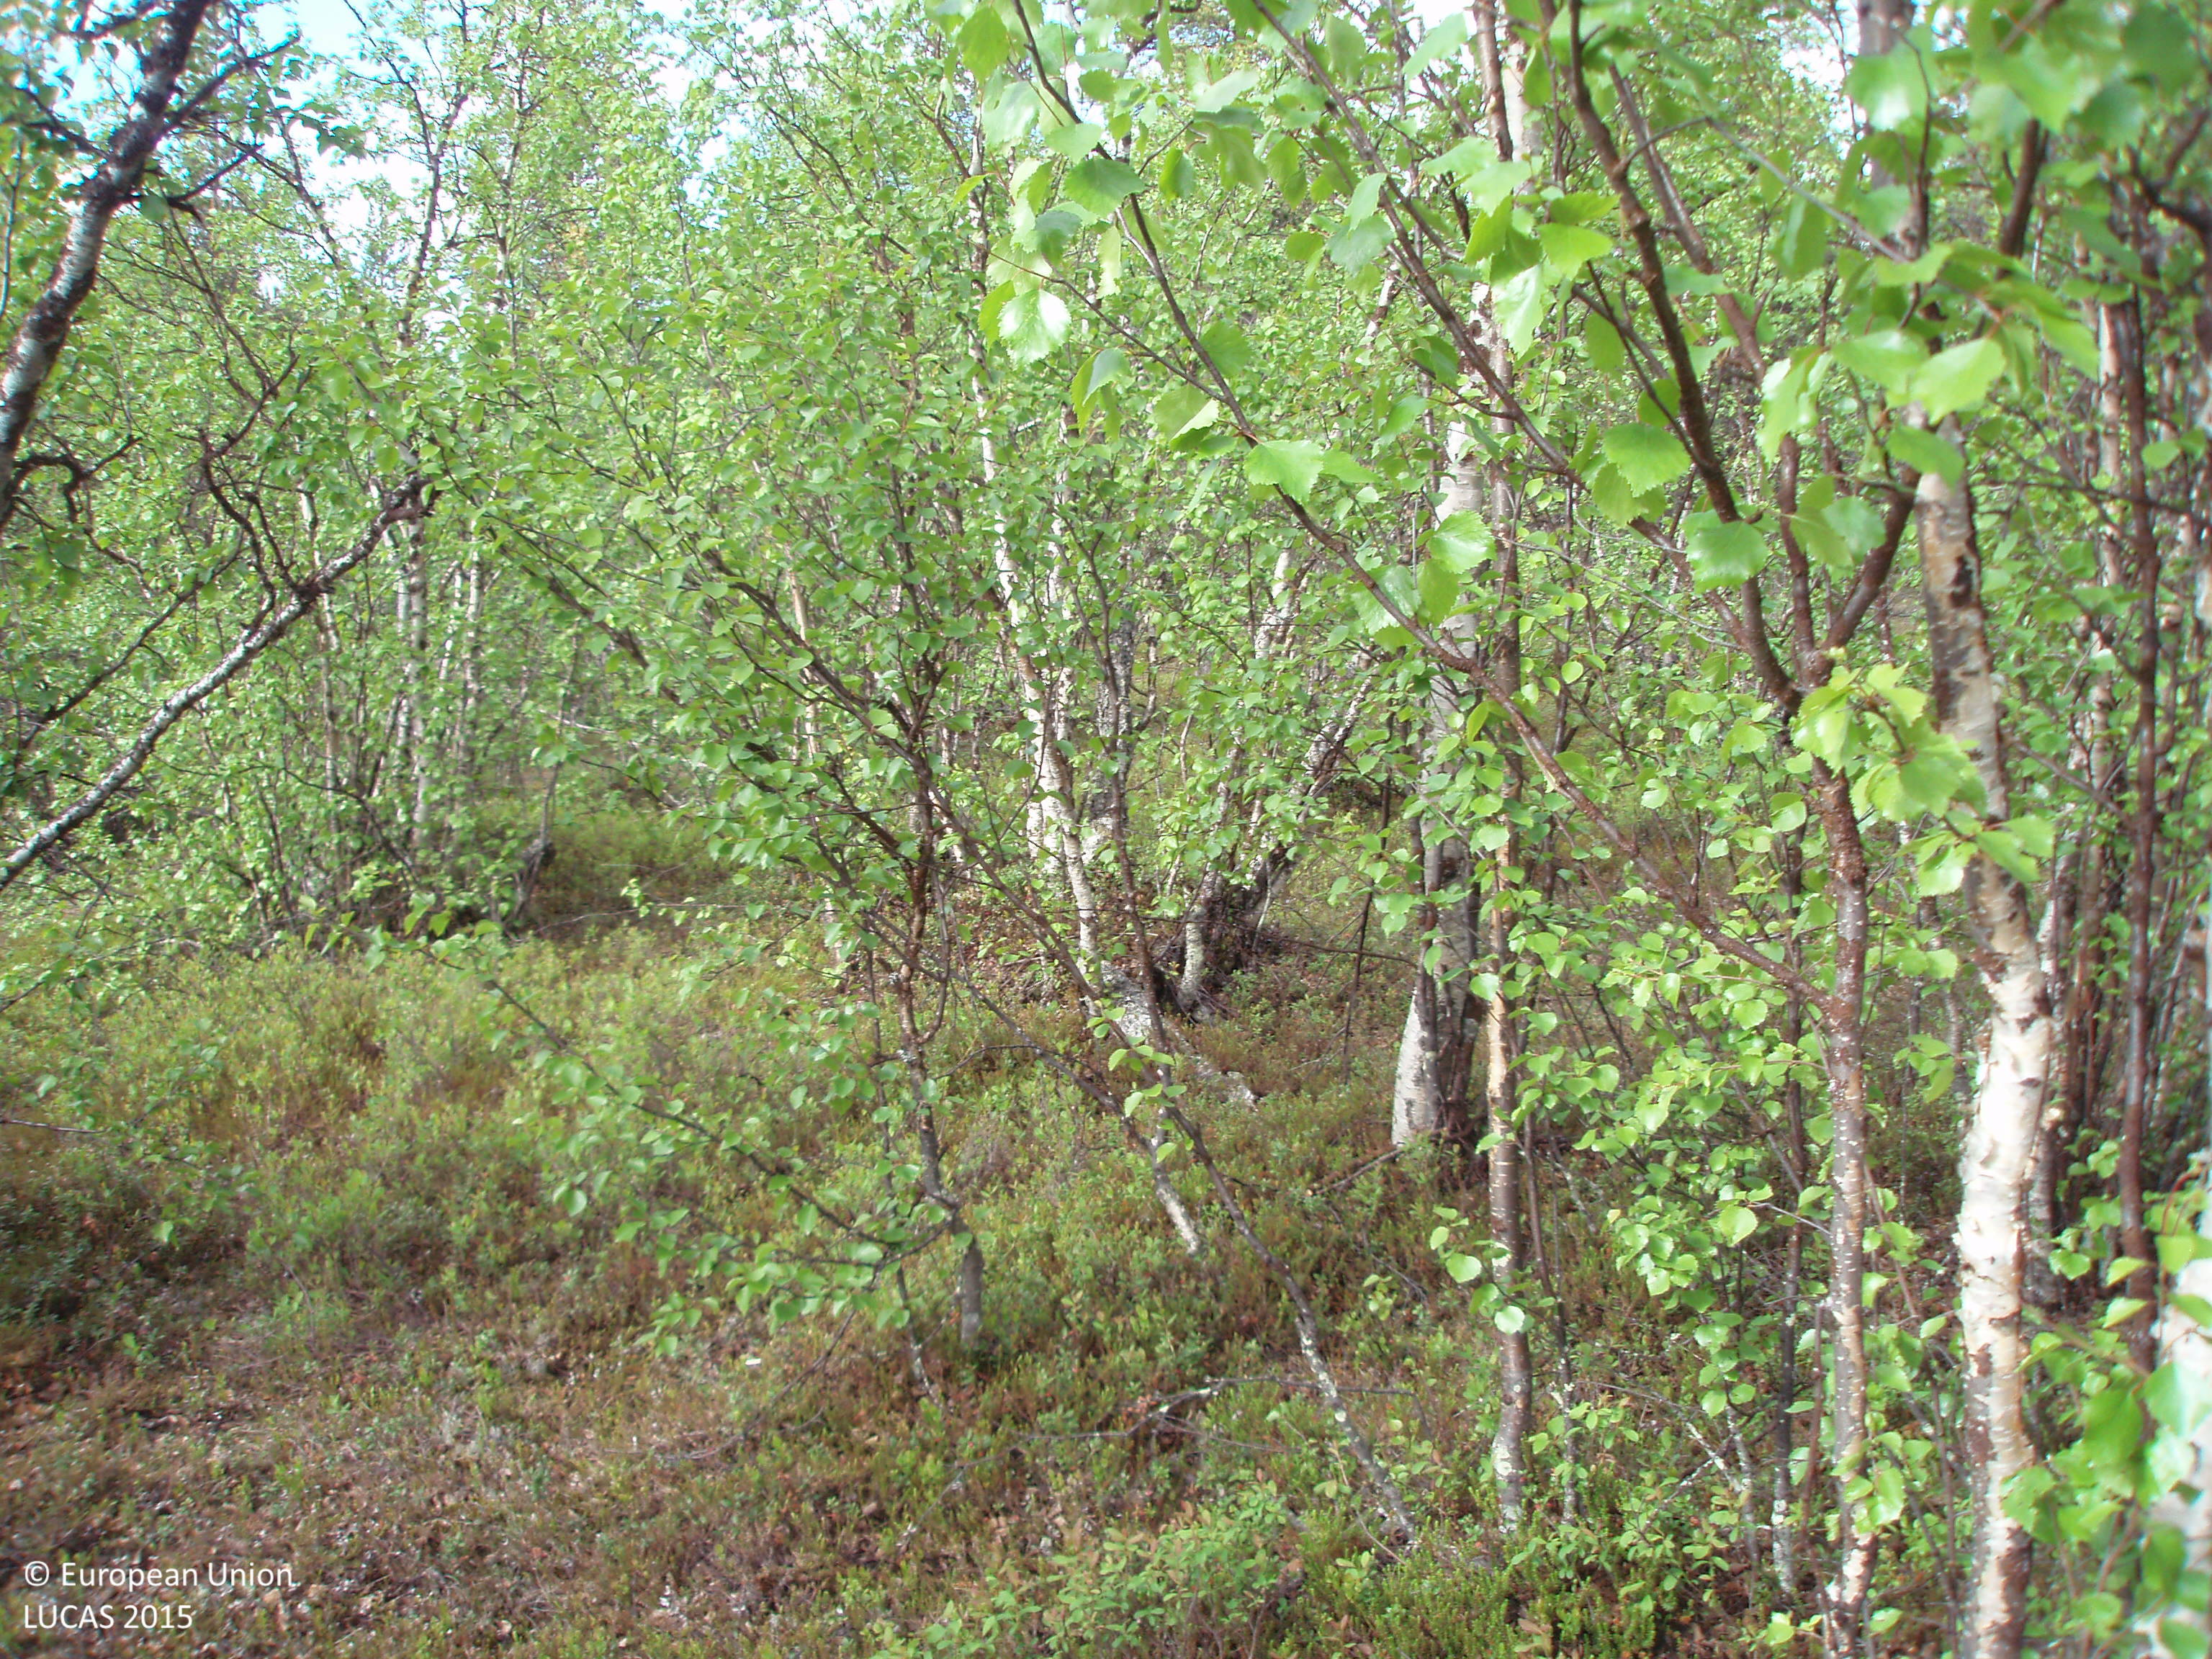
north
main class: Woodland
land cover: Broadleaved woodland
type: boreal forest
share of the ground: > 75 %
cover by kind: broadleaved forest trees 70 %, shrubs 20 %, coniferous forest trees 10 %
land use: Forestry
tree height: > 5 m
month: July
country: FI
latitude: 68.9693
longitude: 25.7353
